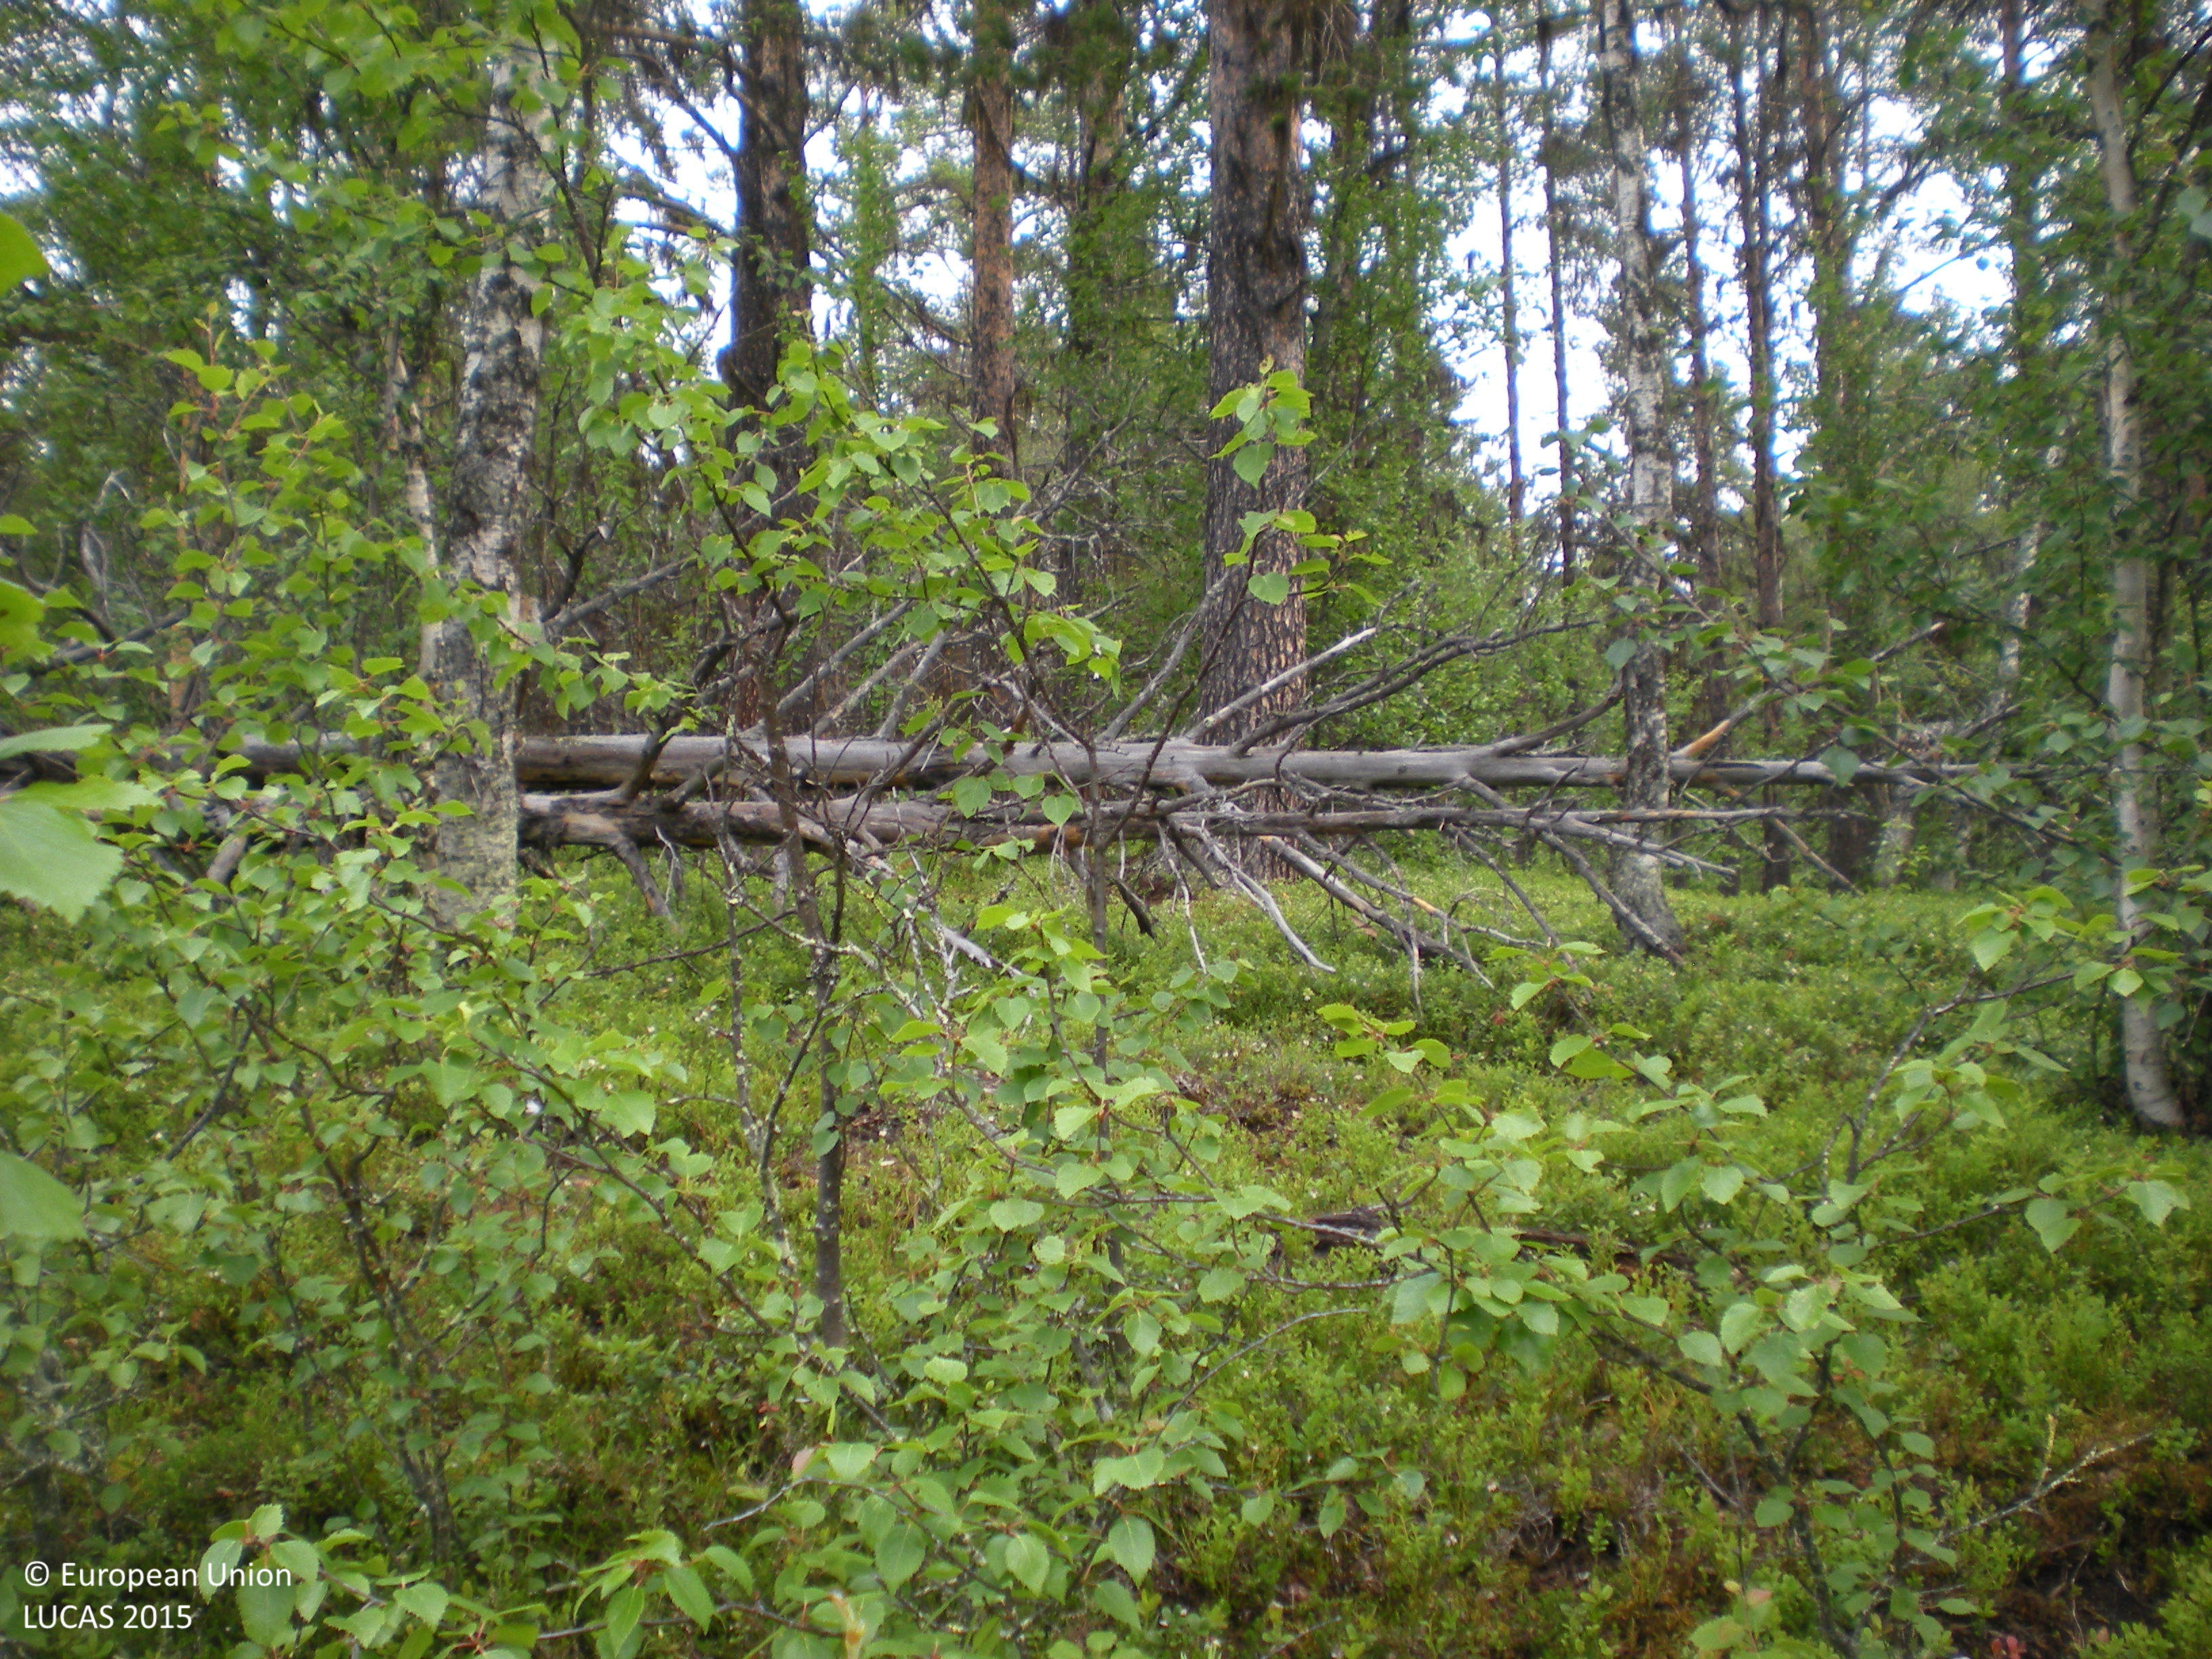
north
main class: Woodland
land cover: Broadleaved woodland
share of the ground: 25 - 50 %
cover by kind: broadleaved forest trees 40 %, shrubs 40 %, lichens and mosses 10 %, coniferous forest trees 5 %, consolidated bare surface 5 %
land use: Forestry
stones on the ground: > 50 %
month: July
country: SE
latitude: 66.2422
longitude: 16.9620
